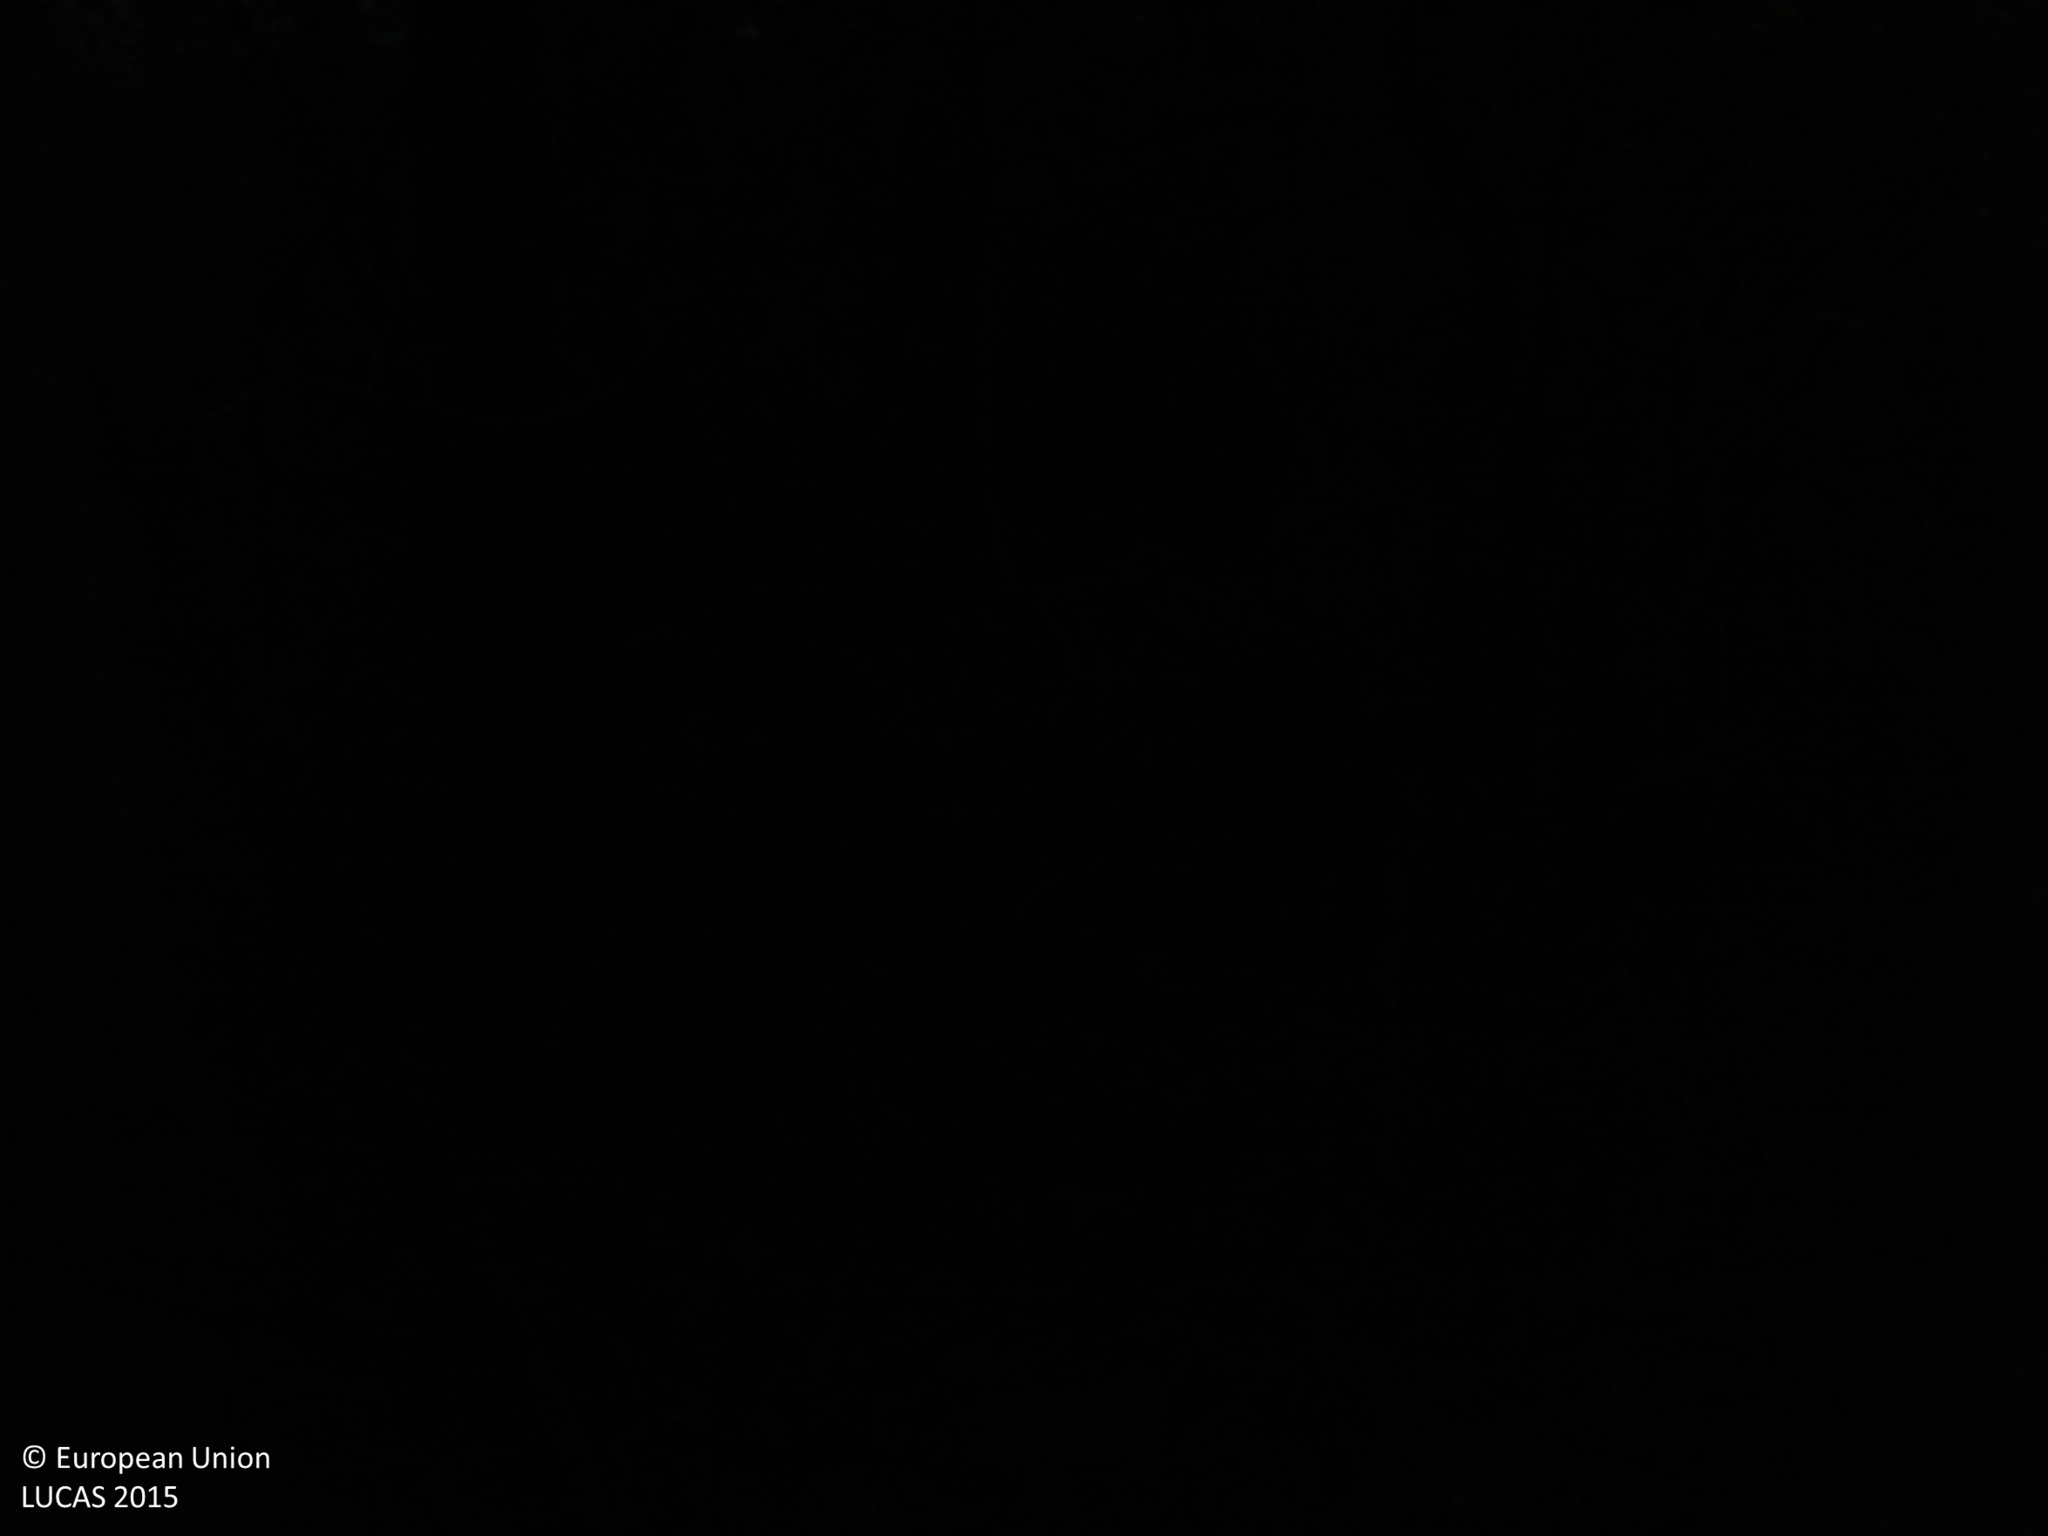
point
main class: Woodland
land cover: Broadleaved woodland
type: acidophilous oak and oak-birch forest
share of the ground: > 75 %
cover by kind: broadleaved forest trees 75 %, shrubs 15 %, herbaceous plants 5 %, lichens and mosses 5 %
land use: Forestry
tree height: > 5 m
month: September
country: FR
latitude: 43.4171
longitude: -0.4942
